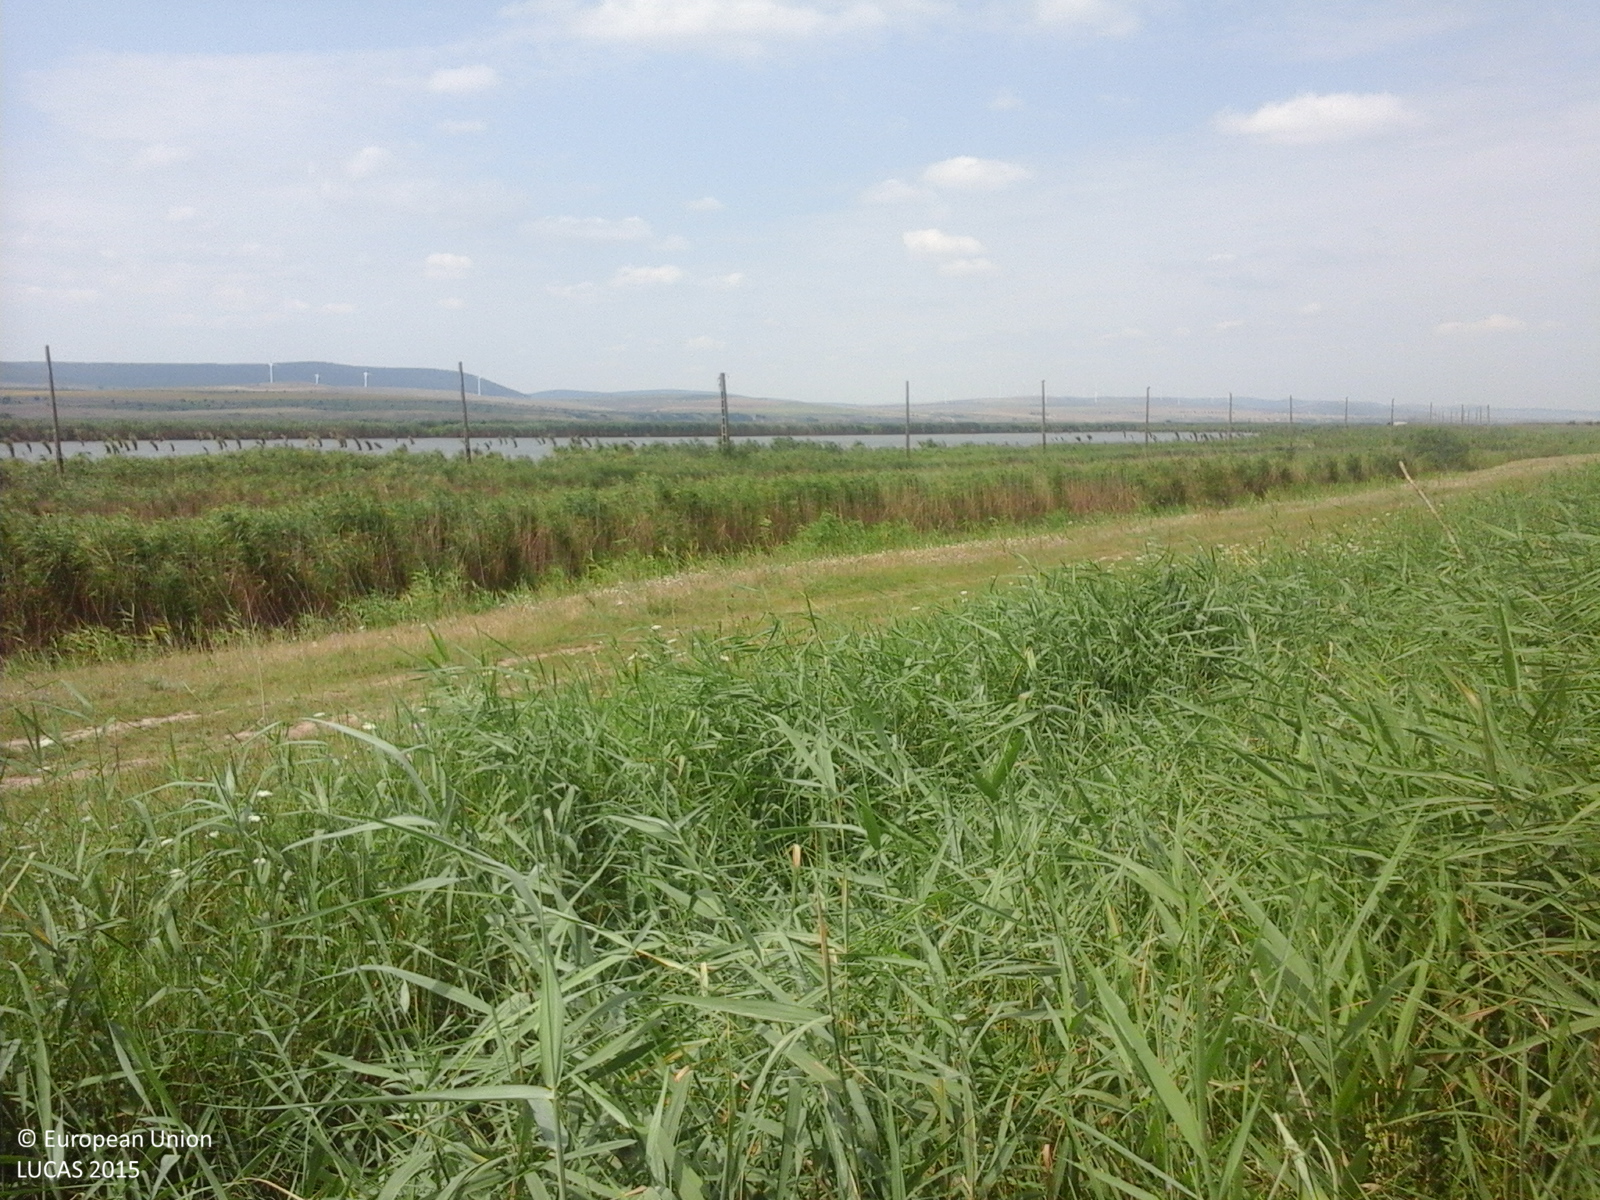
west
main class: Grassland
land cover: Grassland without tree/shrub cover
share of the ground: > 75 %
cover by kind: herbaceous plants 100 %
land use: Agriculture (excluding fallow land and kitchen gardens)
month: August
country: RO
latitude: 44.9013
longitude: 28.8181
